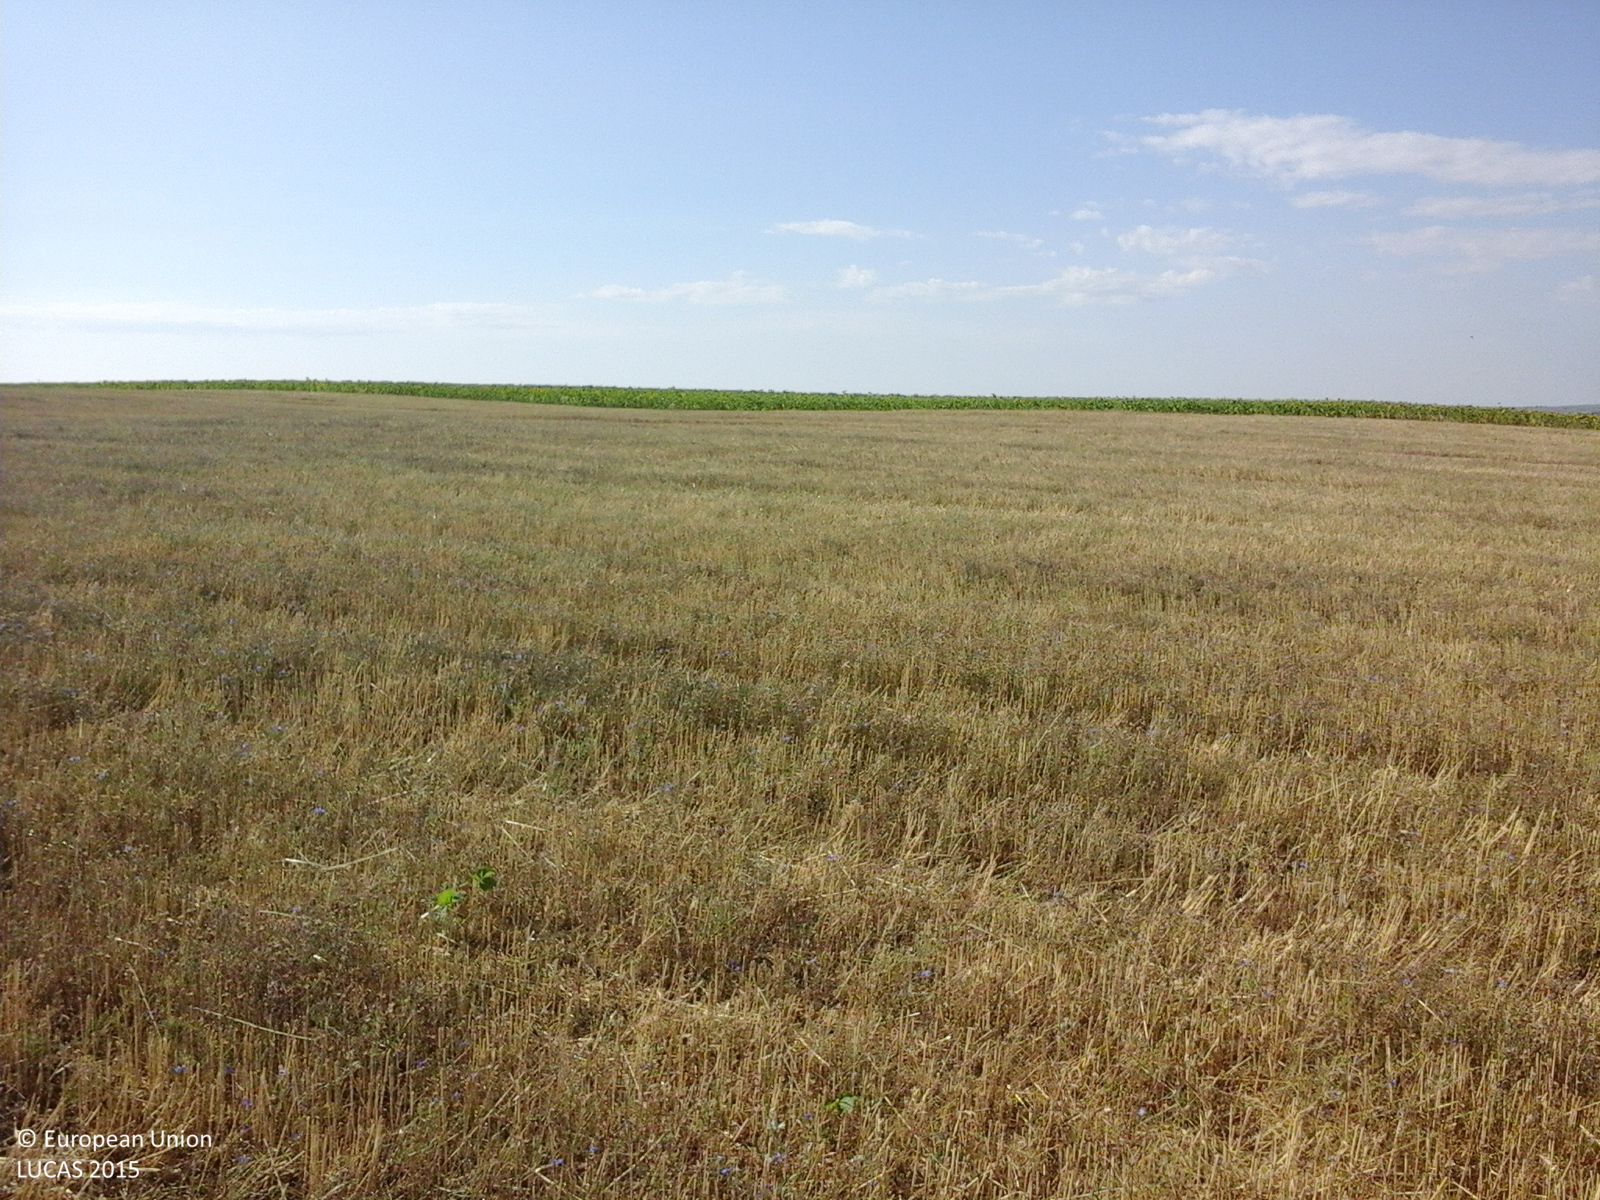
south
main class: Cropland
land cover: Common wheat
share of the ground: > 75 %
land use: Agriculture (excluding fallow land and kitchen gardens)
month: July
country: RO
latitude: 46.0956
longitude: 27.6916
